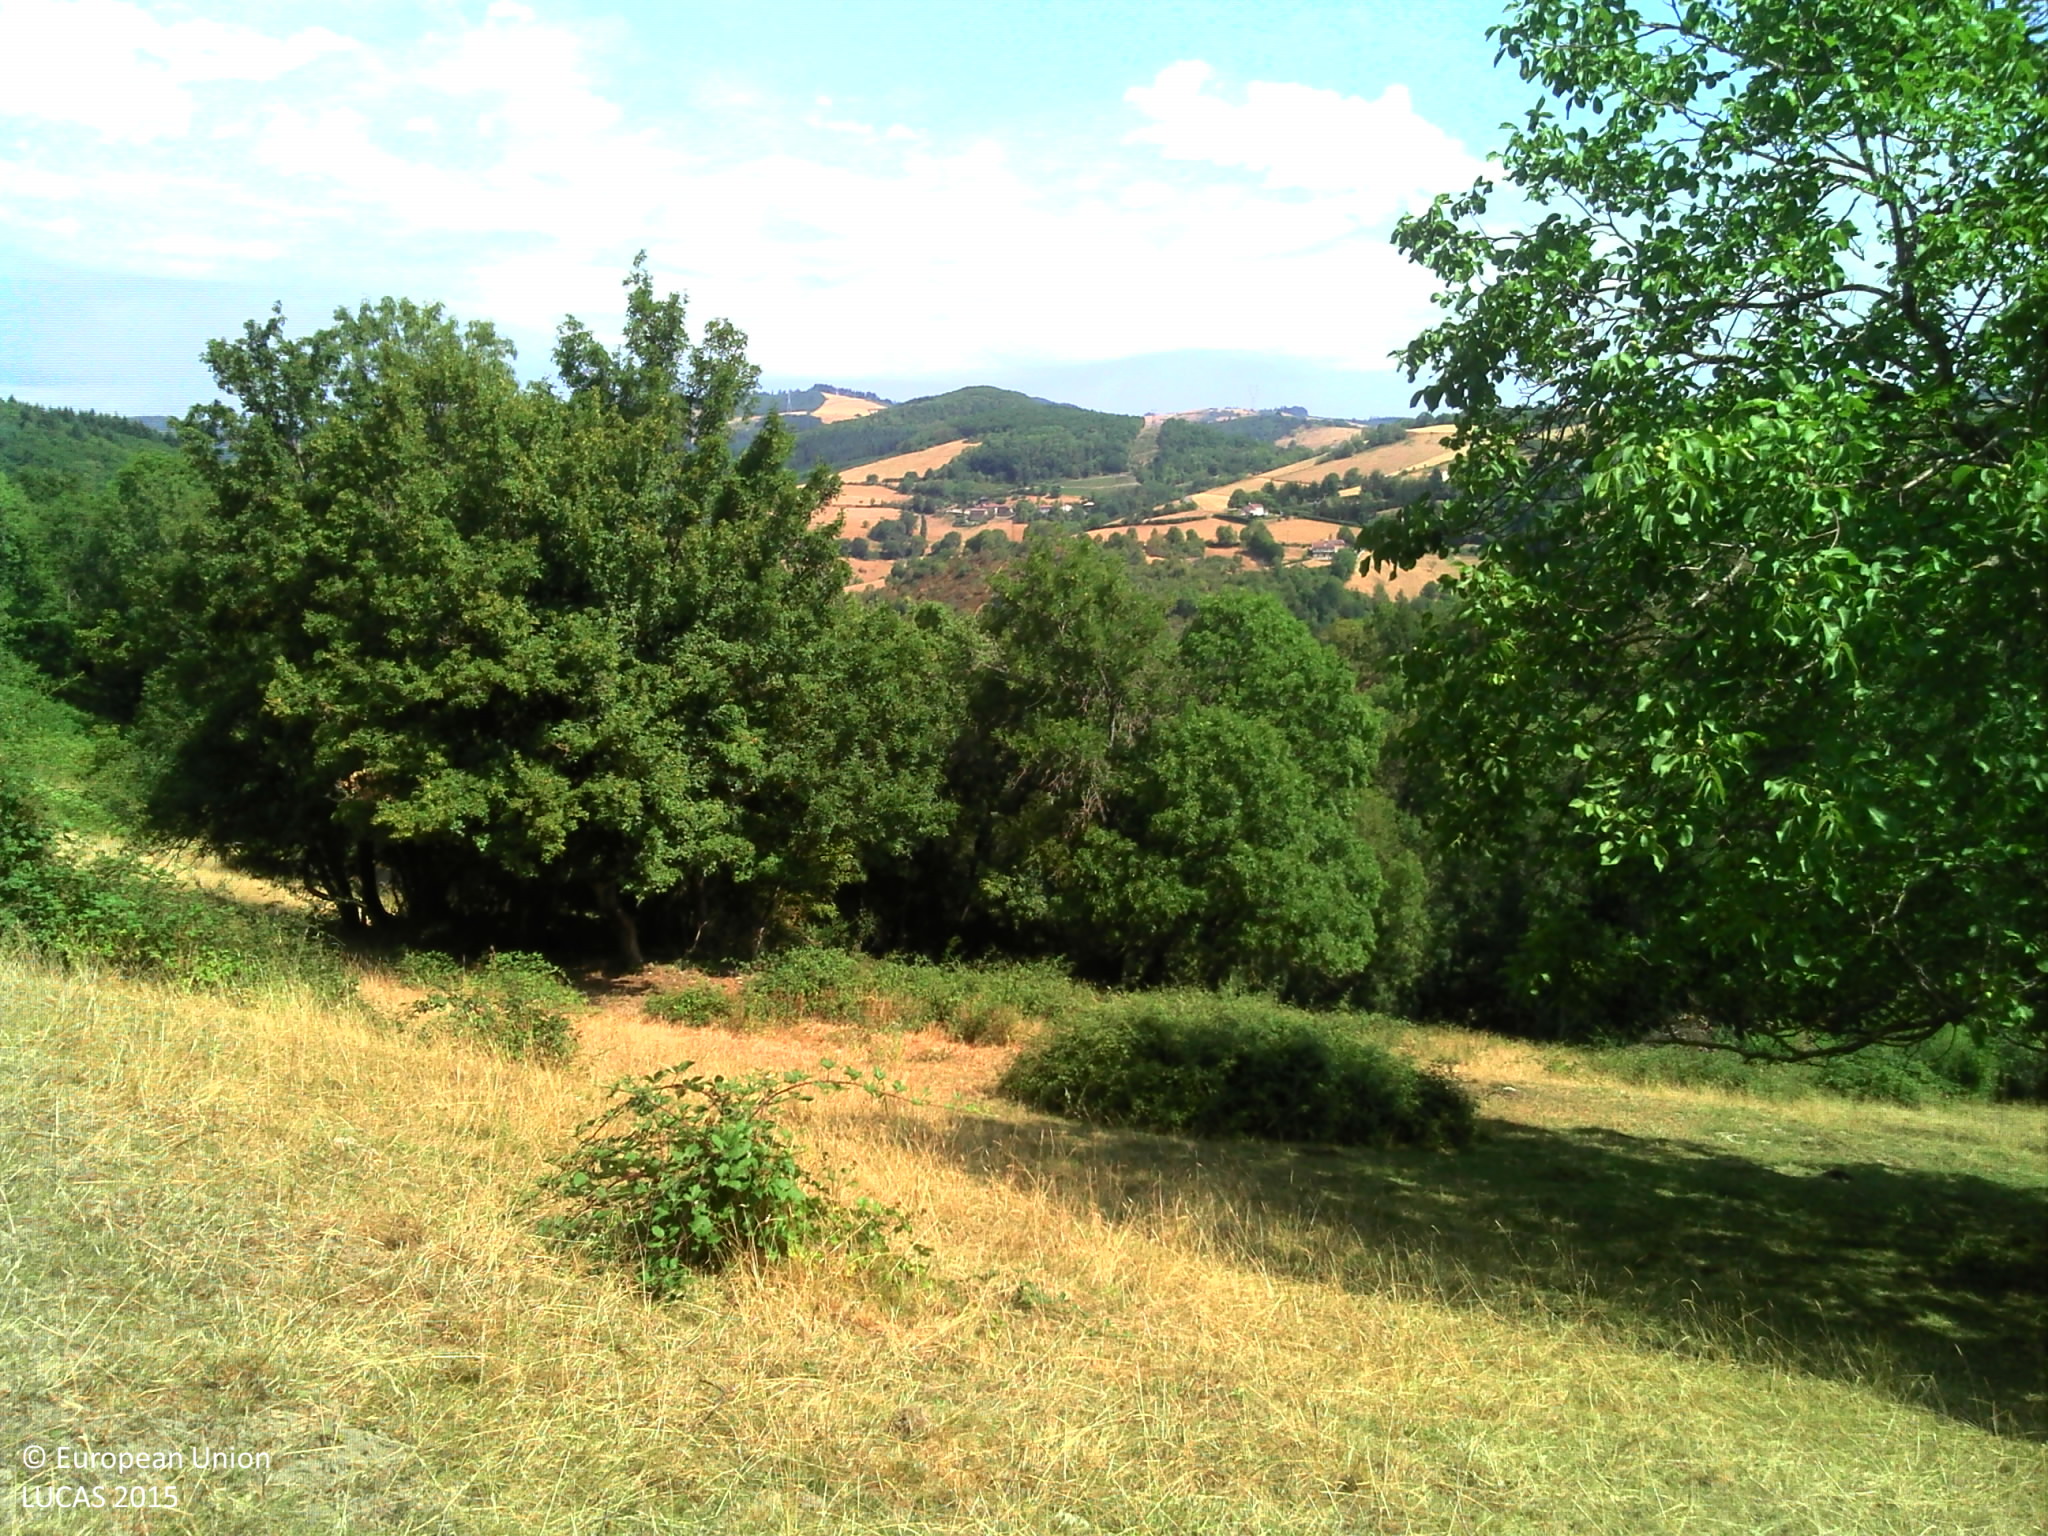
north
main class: Grassland
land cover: Grassland with sparse tree/shrub cover
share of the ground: > 75 %
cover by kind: herbaceous plants 90 %, broadleaved forest trees 5 %, shrubs 5 %
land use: Agriculture (excluding fallow land and kitchen gardens)
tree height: < 5 m
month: July
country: FR
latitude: 45.9180
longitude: 4.4456
